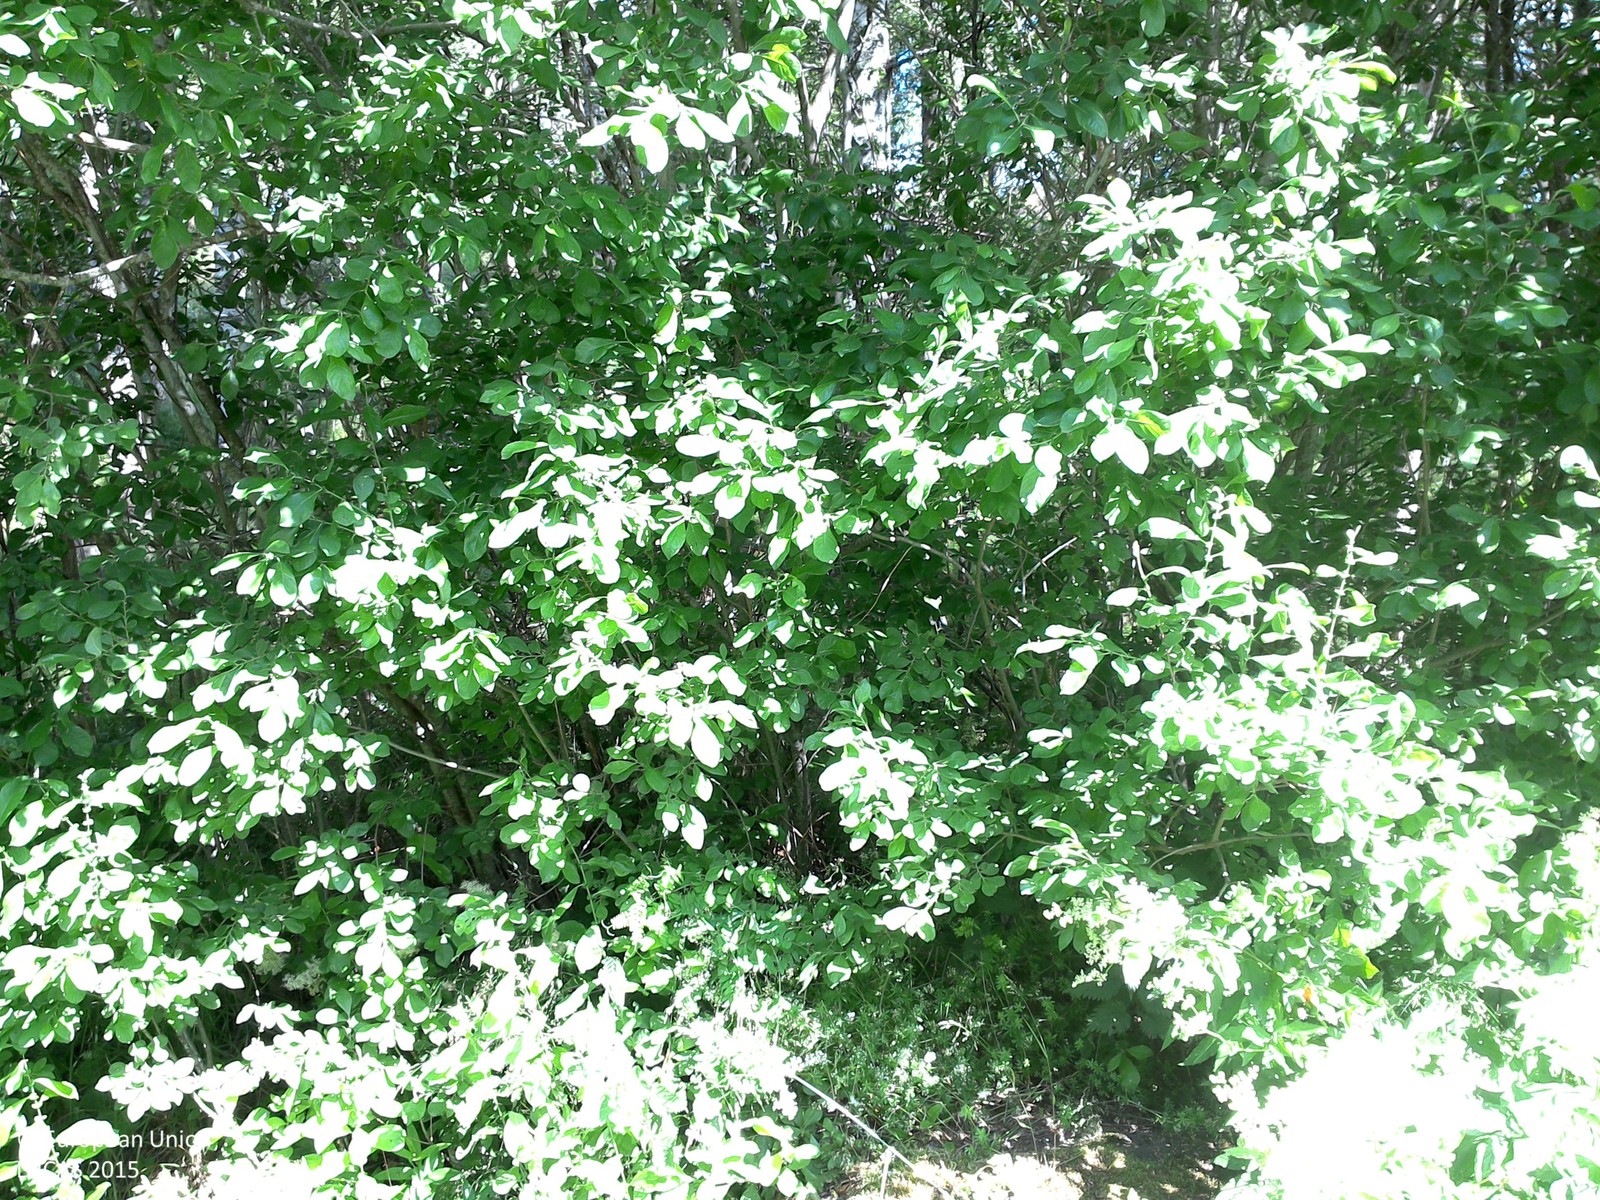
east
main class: Grassland
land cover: Grassland without tree/shrub cover
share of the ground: > 75 %
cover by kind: herbaceous plants 100 %
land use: Road transport
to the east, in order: Grassland without tree/shrub cover; Ditches and canals; Broadleaved woodland; Grassland with sparse tree/shrub cover; Fences; Broadleaved woodland; Grassland with sparse tree/shrub cover; Pine dominated mixed woodland; Grassland with sparse tree/shrub cover; Fences; Ditches and canals; Grassland without tree/shrub cover; Paved roads, cycling and walking lanes; Broadleaved woodland
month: July
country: SE
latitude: 58.1362
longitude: 14.7329
